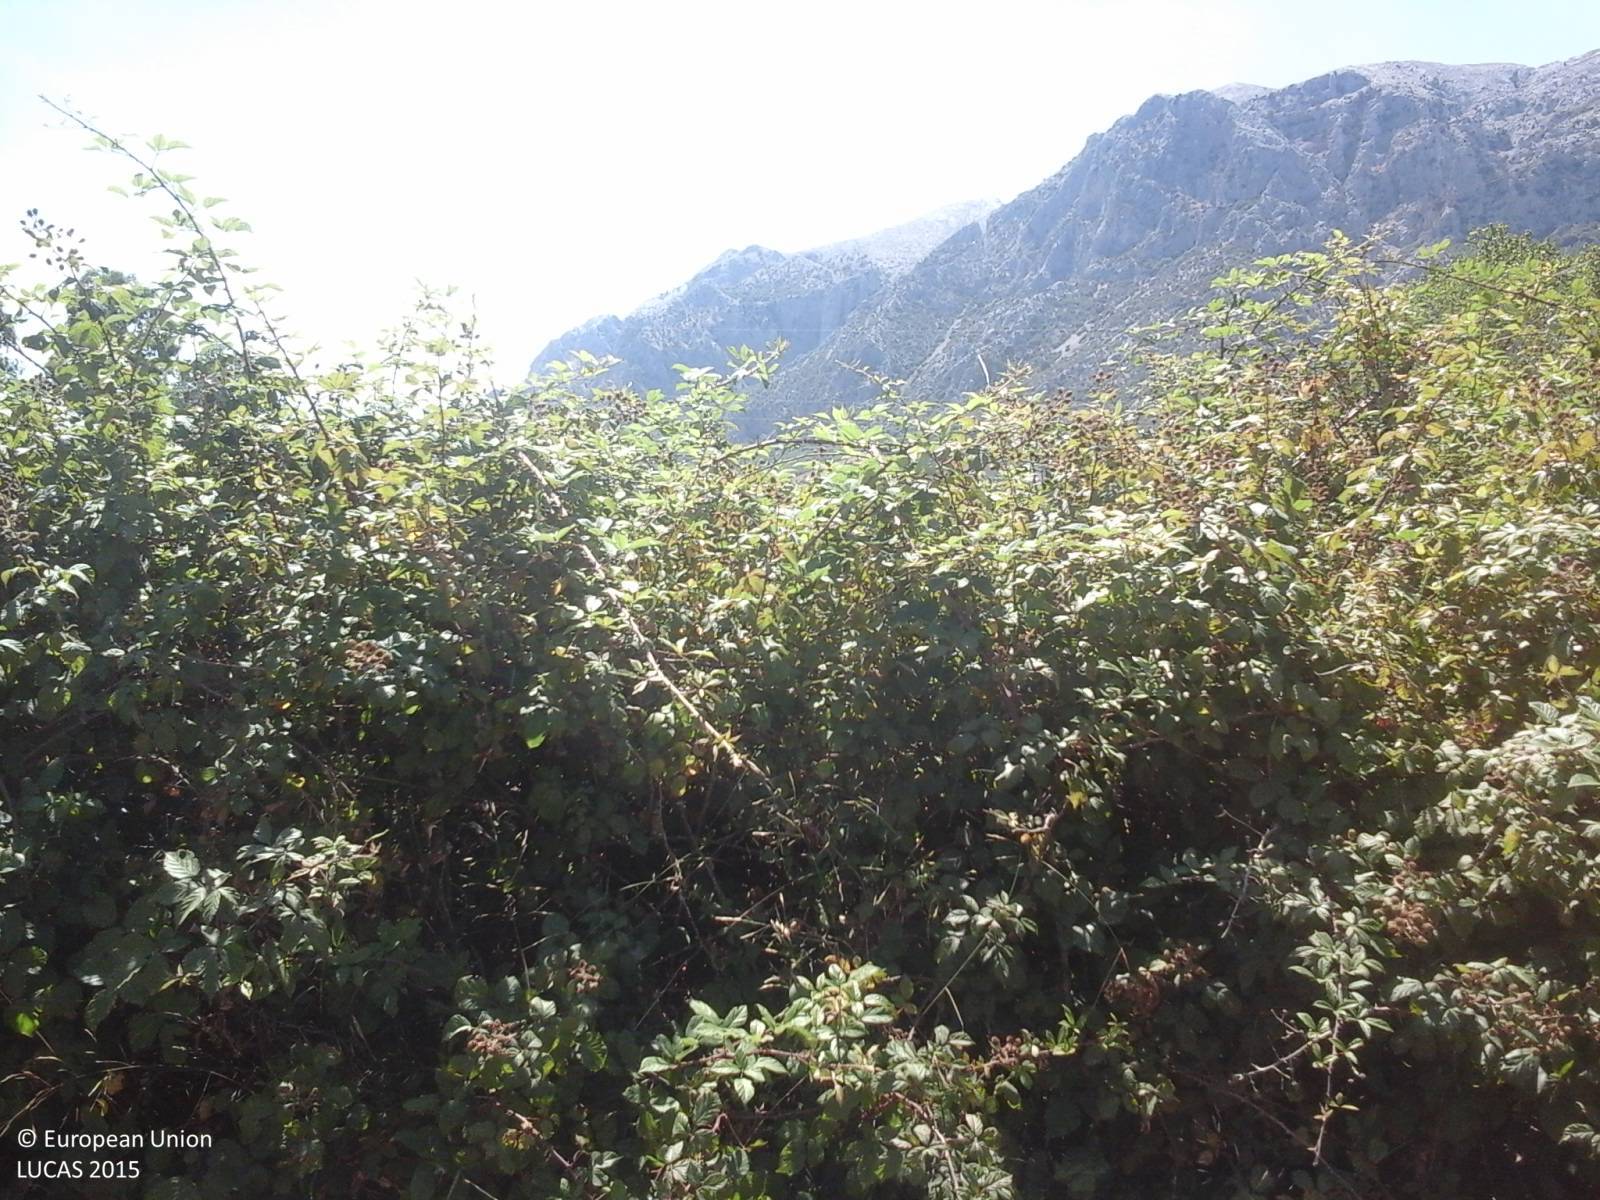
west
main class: Grassland
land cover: Grassland without tree/shrub cover
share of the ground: > 75 %
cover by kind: herbaceous plants 90 %, shrubs 5 %, unconsolidated bare surface 5 %
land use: Agriculture (excluding fallow land and kitchen gardens)
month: June
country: IT
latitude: 40.5564
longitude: 9.6827
